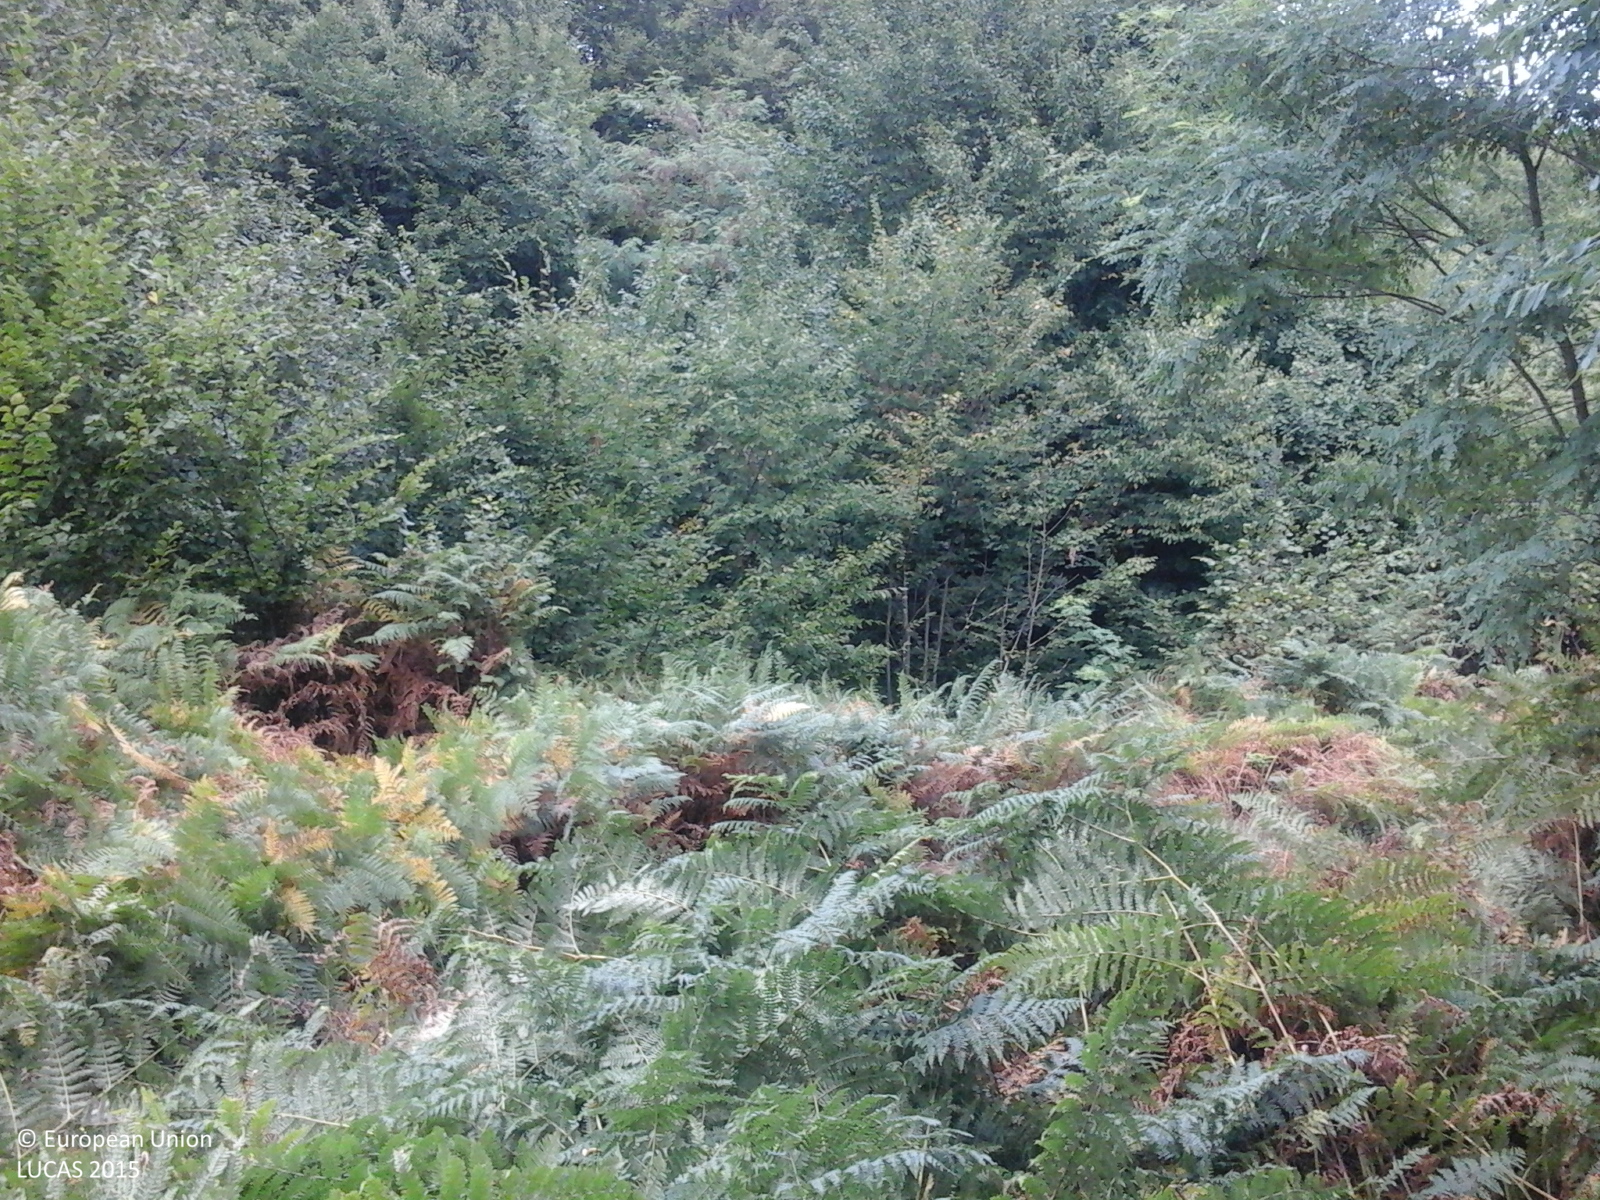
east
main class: Woodland
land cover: Broadleaved woodland
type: broadleaved evergreen forest
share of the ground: > 75 %
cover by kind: broadleaved forest trees 100 %
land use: Forestry
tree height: > 5 m
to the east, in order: Broadleaved woodland; Tracks; Spontaneously vegetated surfaces; Broadleaved woodland; Grassland with sparse tree/shrub cover
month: August
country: RO
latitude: 45.2065
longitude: 21.9400
